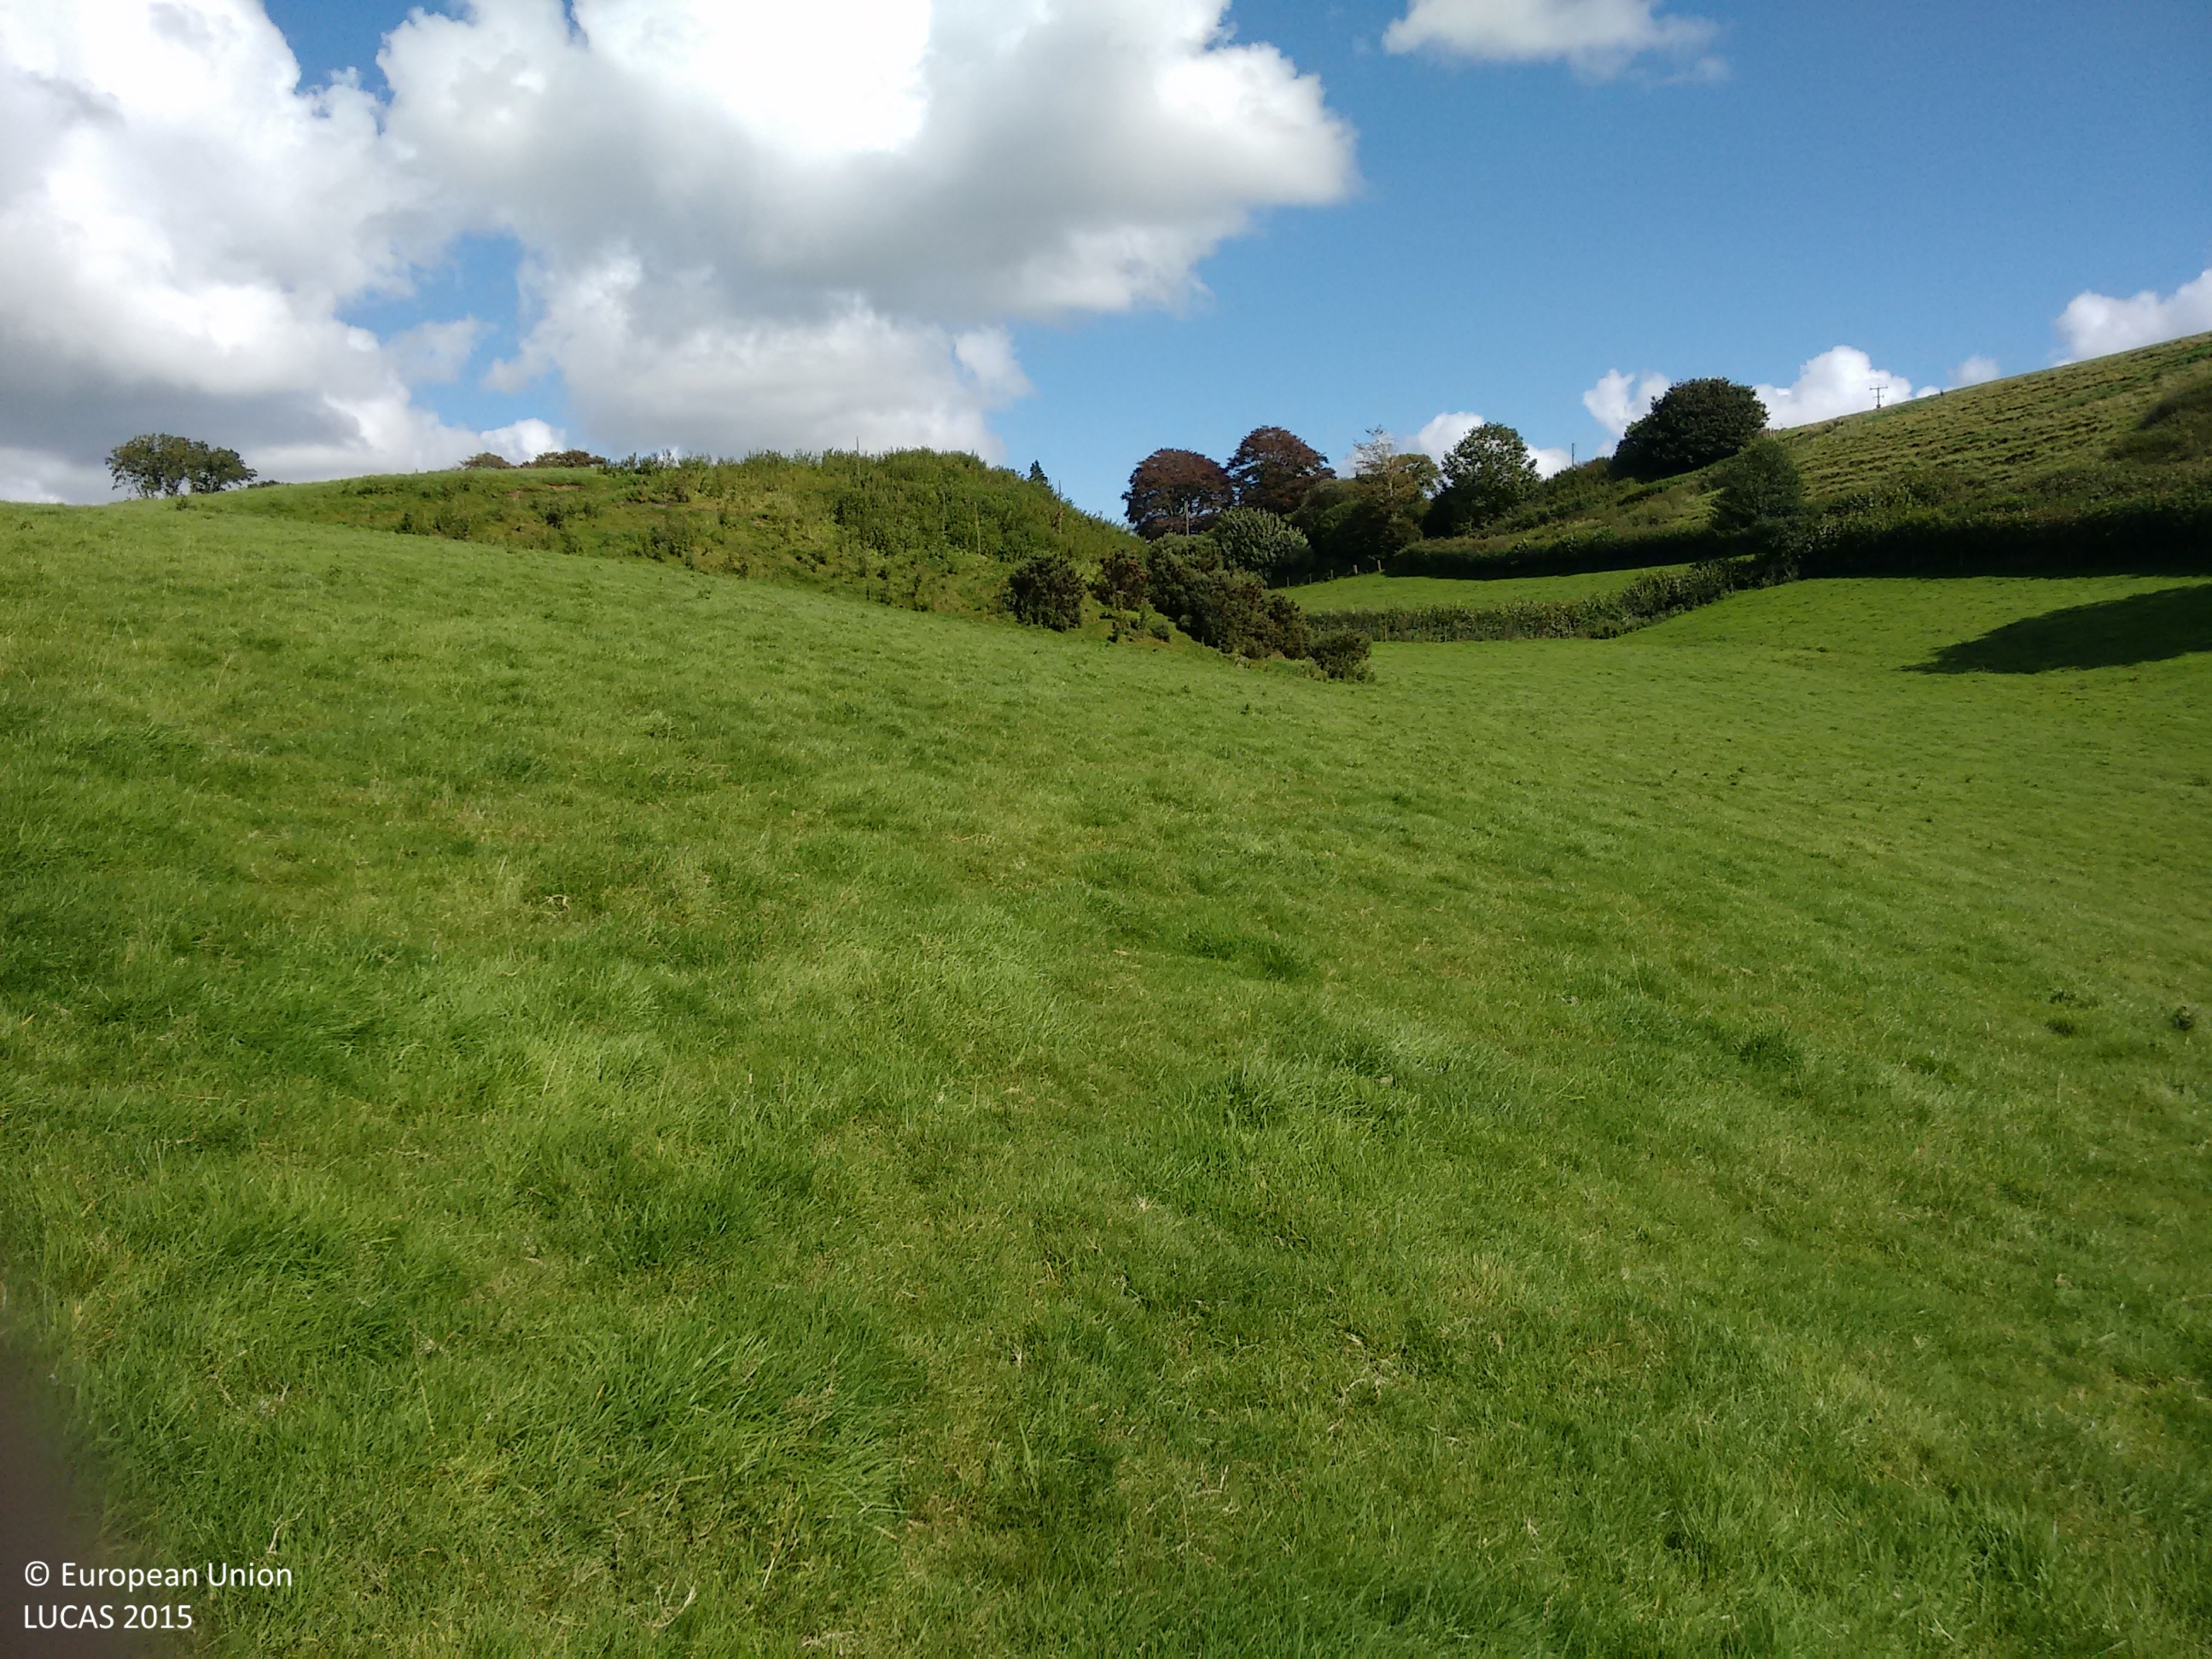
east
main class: Grassland
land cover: Grassland without tree/shrub cover
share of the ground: > 75 %
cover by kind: herbaceous plants 100 %
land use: Agriculture (excluding fallow land and kitchen gardens)
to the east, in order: Grassland without tree/shrub cover; Shrubland without tree cover; Grassland without tree/shrub cover; Fences; Ditches and canals; Managed hedges; Fences; Grassland without tree/shrub cover; Artificial constructions in urban areas
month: August
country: GB
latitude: 51.0166
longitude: -3.8179
